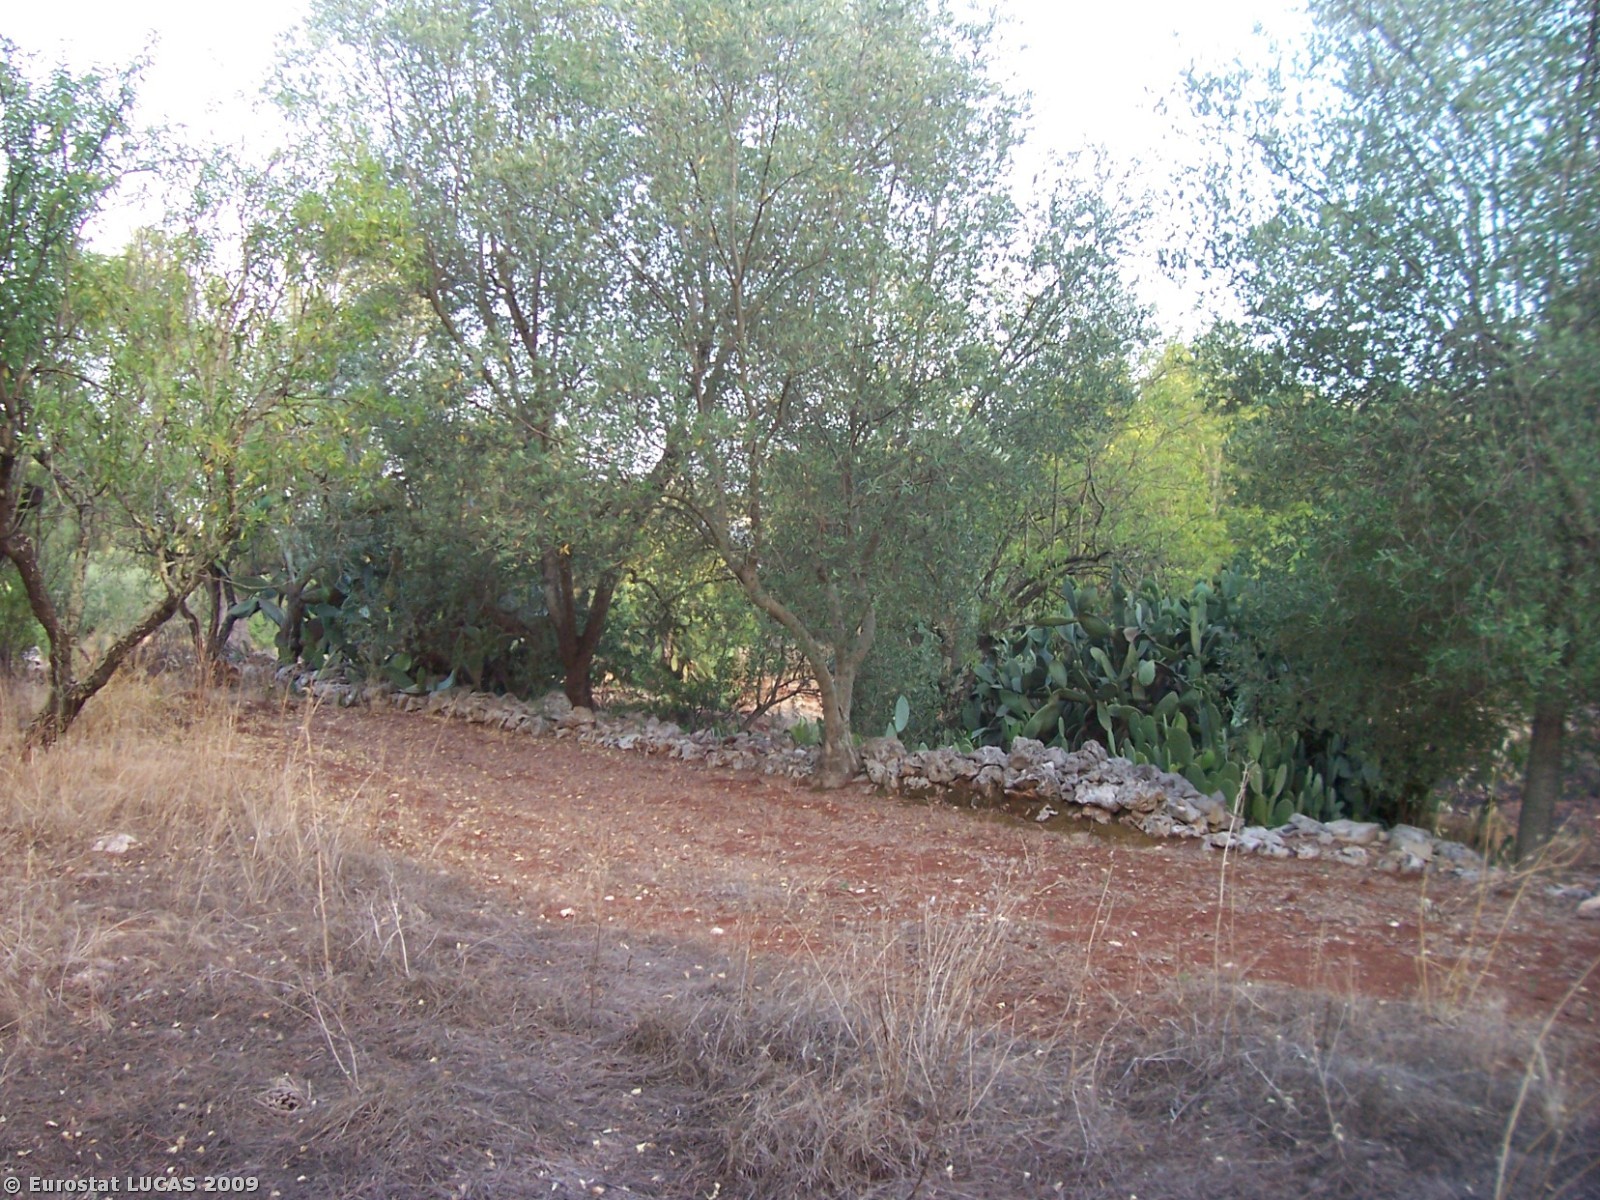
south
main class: Cropland
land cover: Nuts trees
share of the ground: 25 - 50 %
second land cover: Spontaneously vegetated surfaces
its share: > 75 %
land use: Agriculture (excluding fallow land and kitchen gardens)
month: July
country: IT
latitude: 40.6656
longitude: 17.5592
